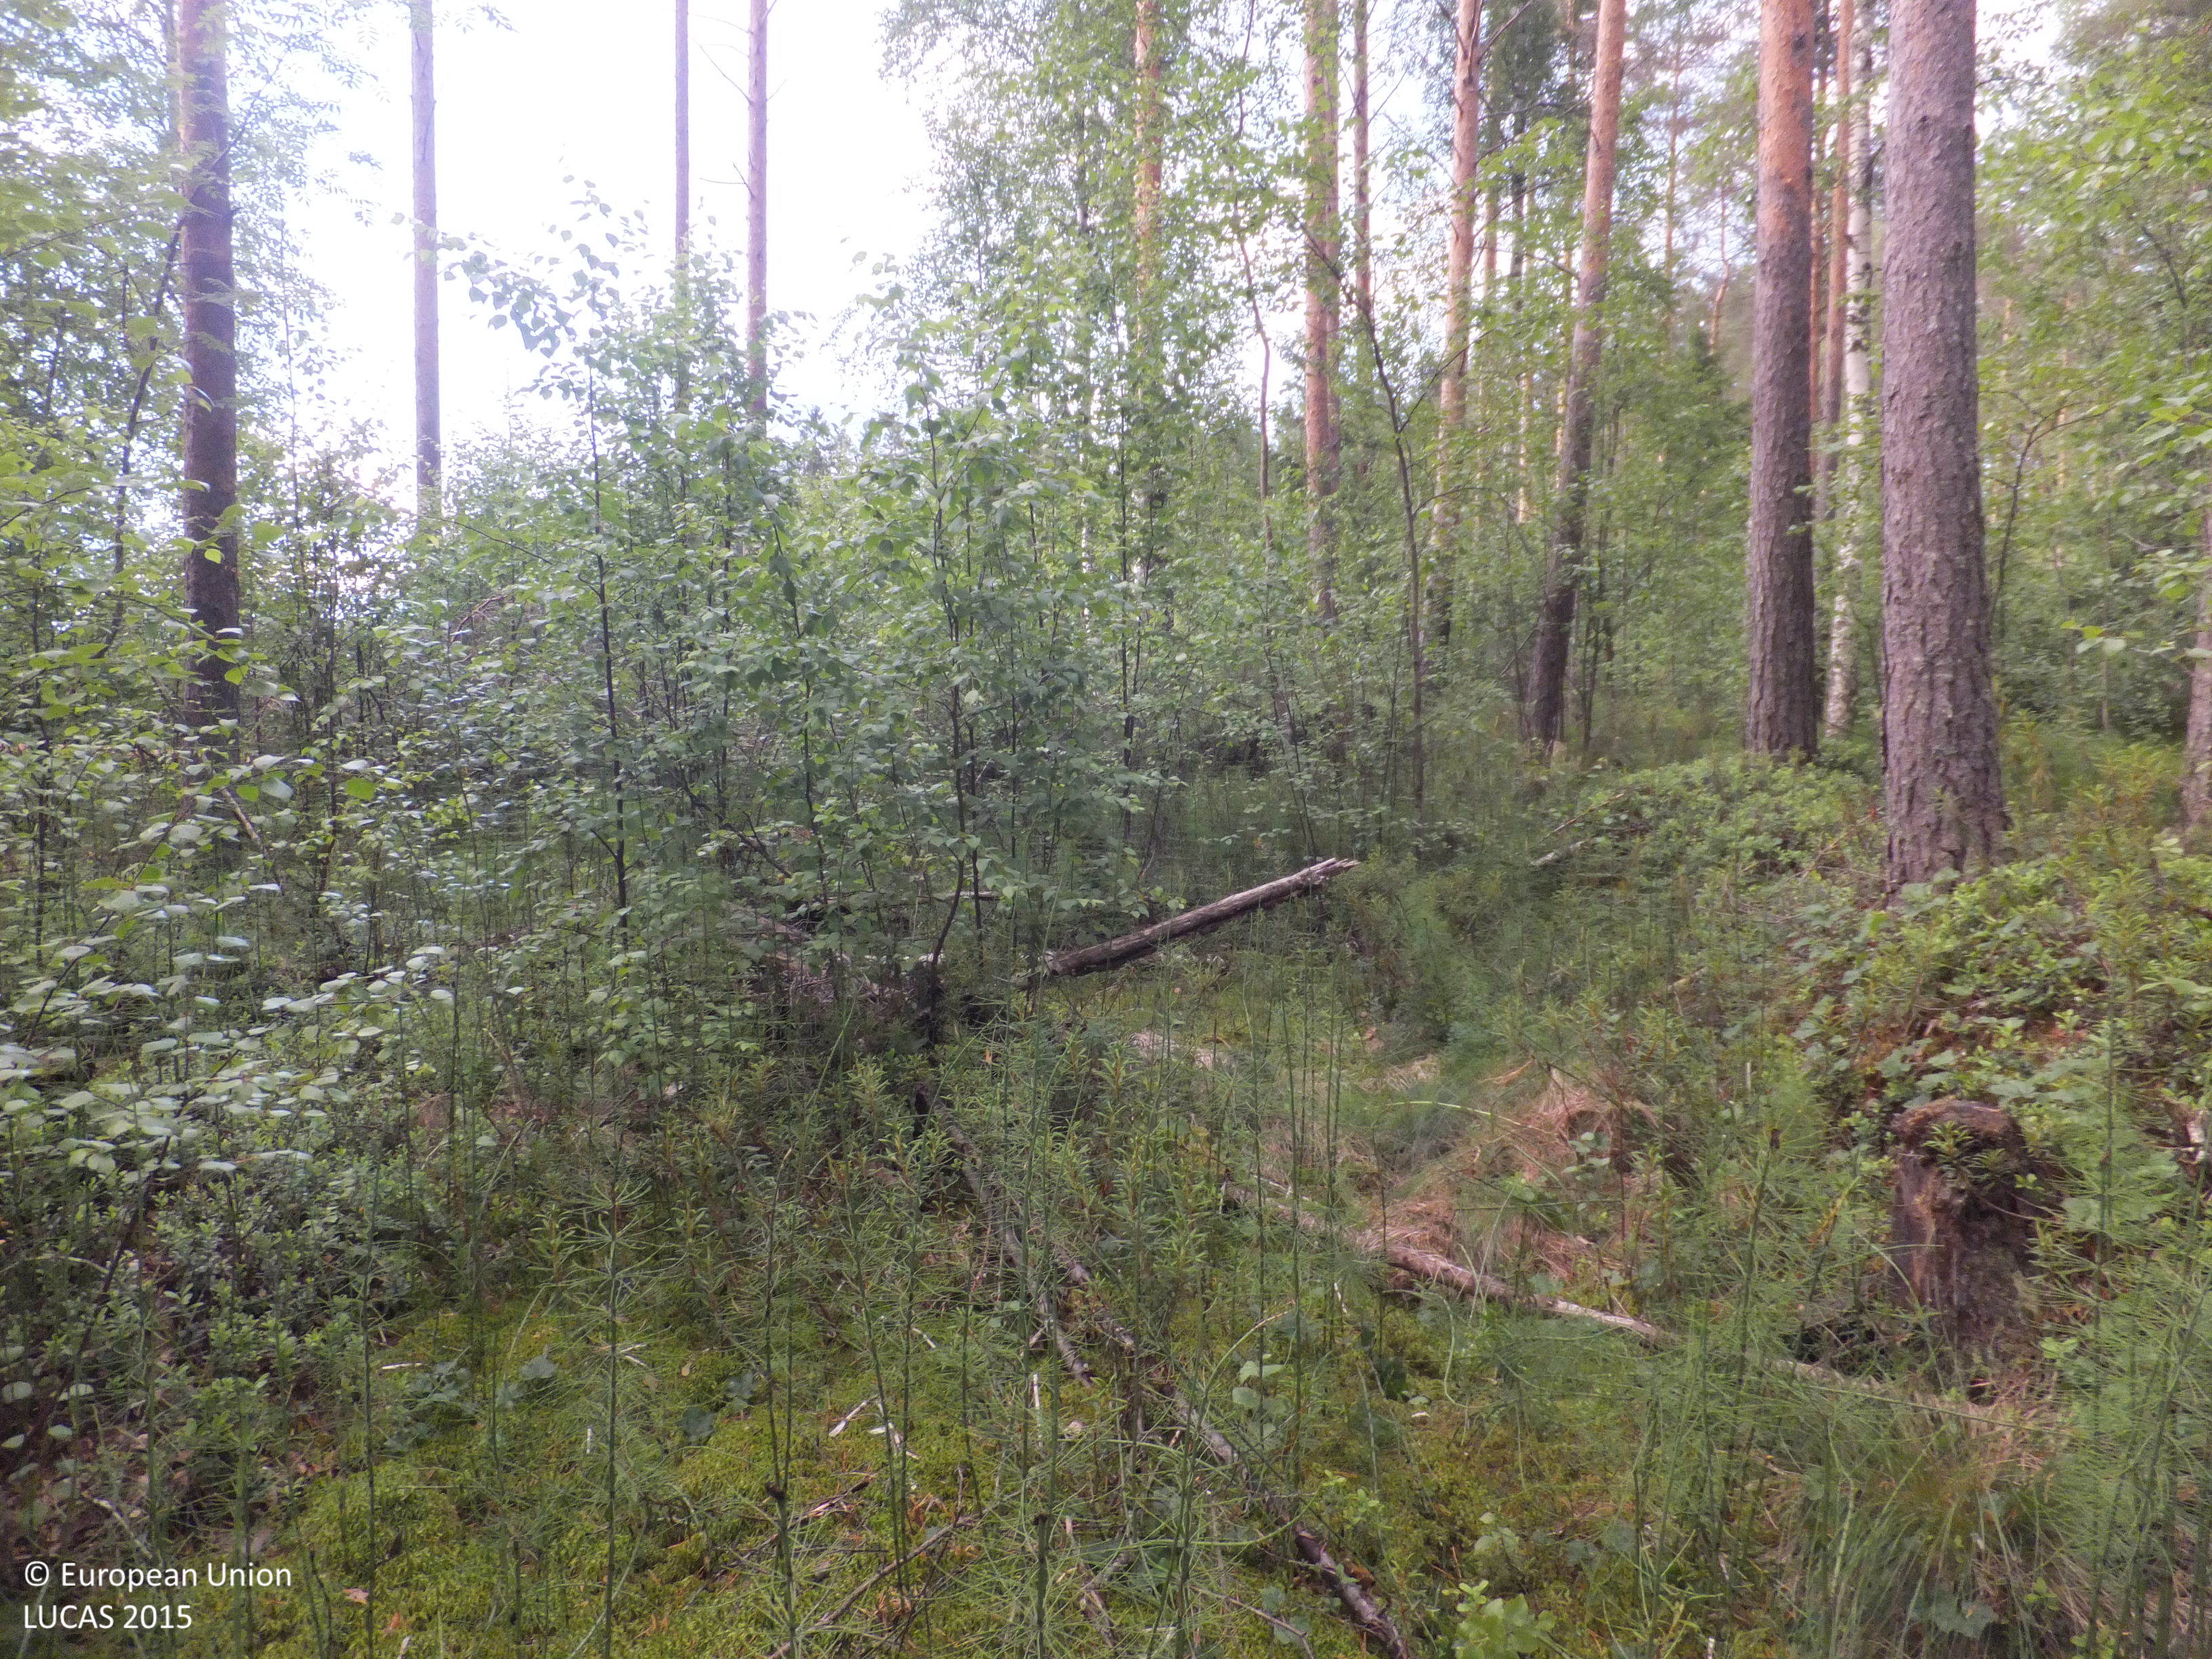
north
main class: Woodland
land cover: Pine dominated mixed woodland
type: boreal forest
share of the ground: > 75 %
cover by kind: coniferous forest trees 40 %, broadleaved forest trees 40 %, shrubs 10 %, herbaceous plants 5 %, lichens and mosses 5 %
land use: Forestry
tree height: > 5 m
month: July
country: FI
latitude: 63.0810
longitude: 24.5176
